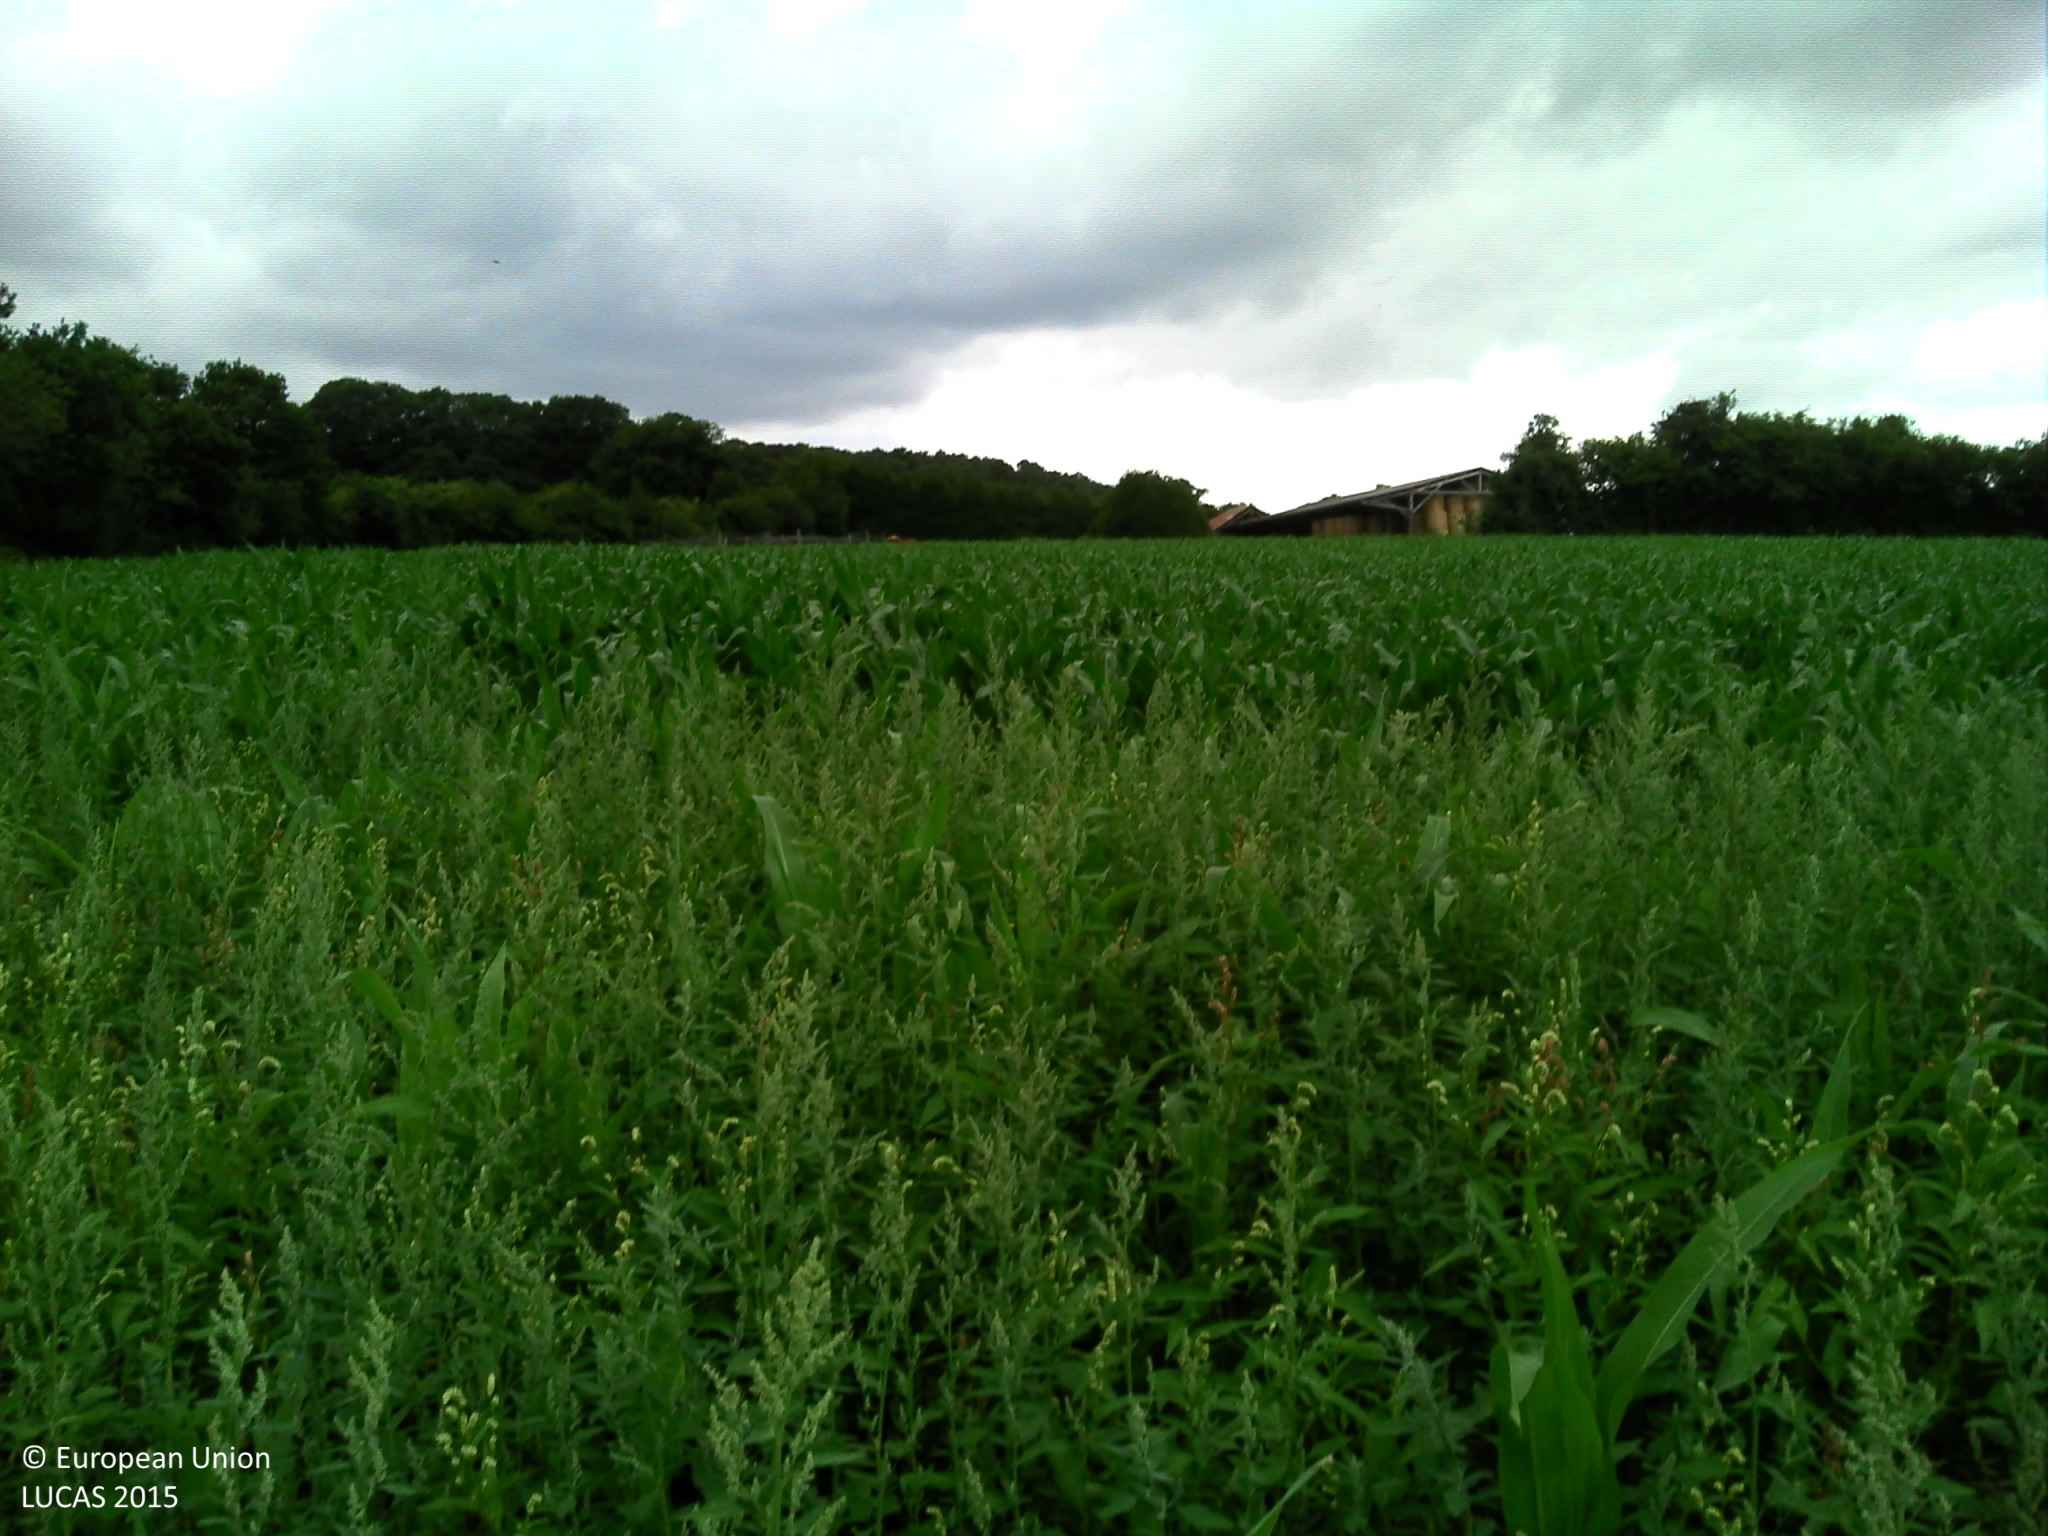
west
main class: Cropland
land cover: Maize
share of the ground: > 75 %
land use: Agriculture (excluding fallow land and kitchen gardens)
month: July
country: FR
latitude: 48.3865
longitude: -0.1722
